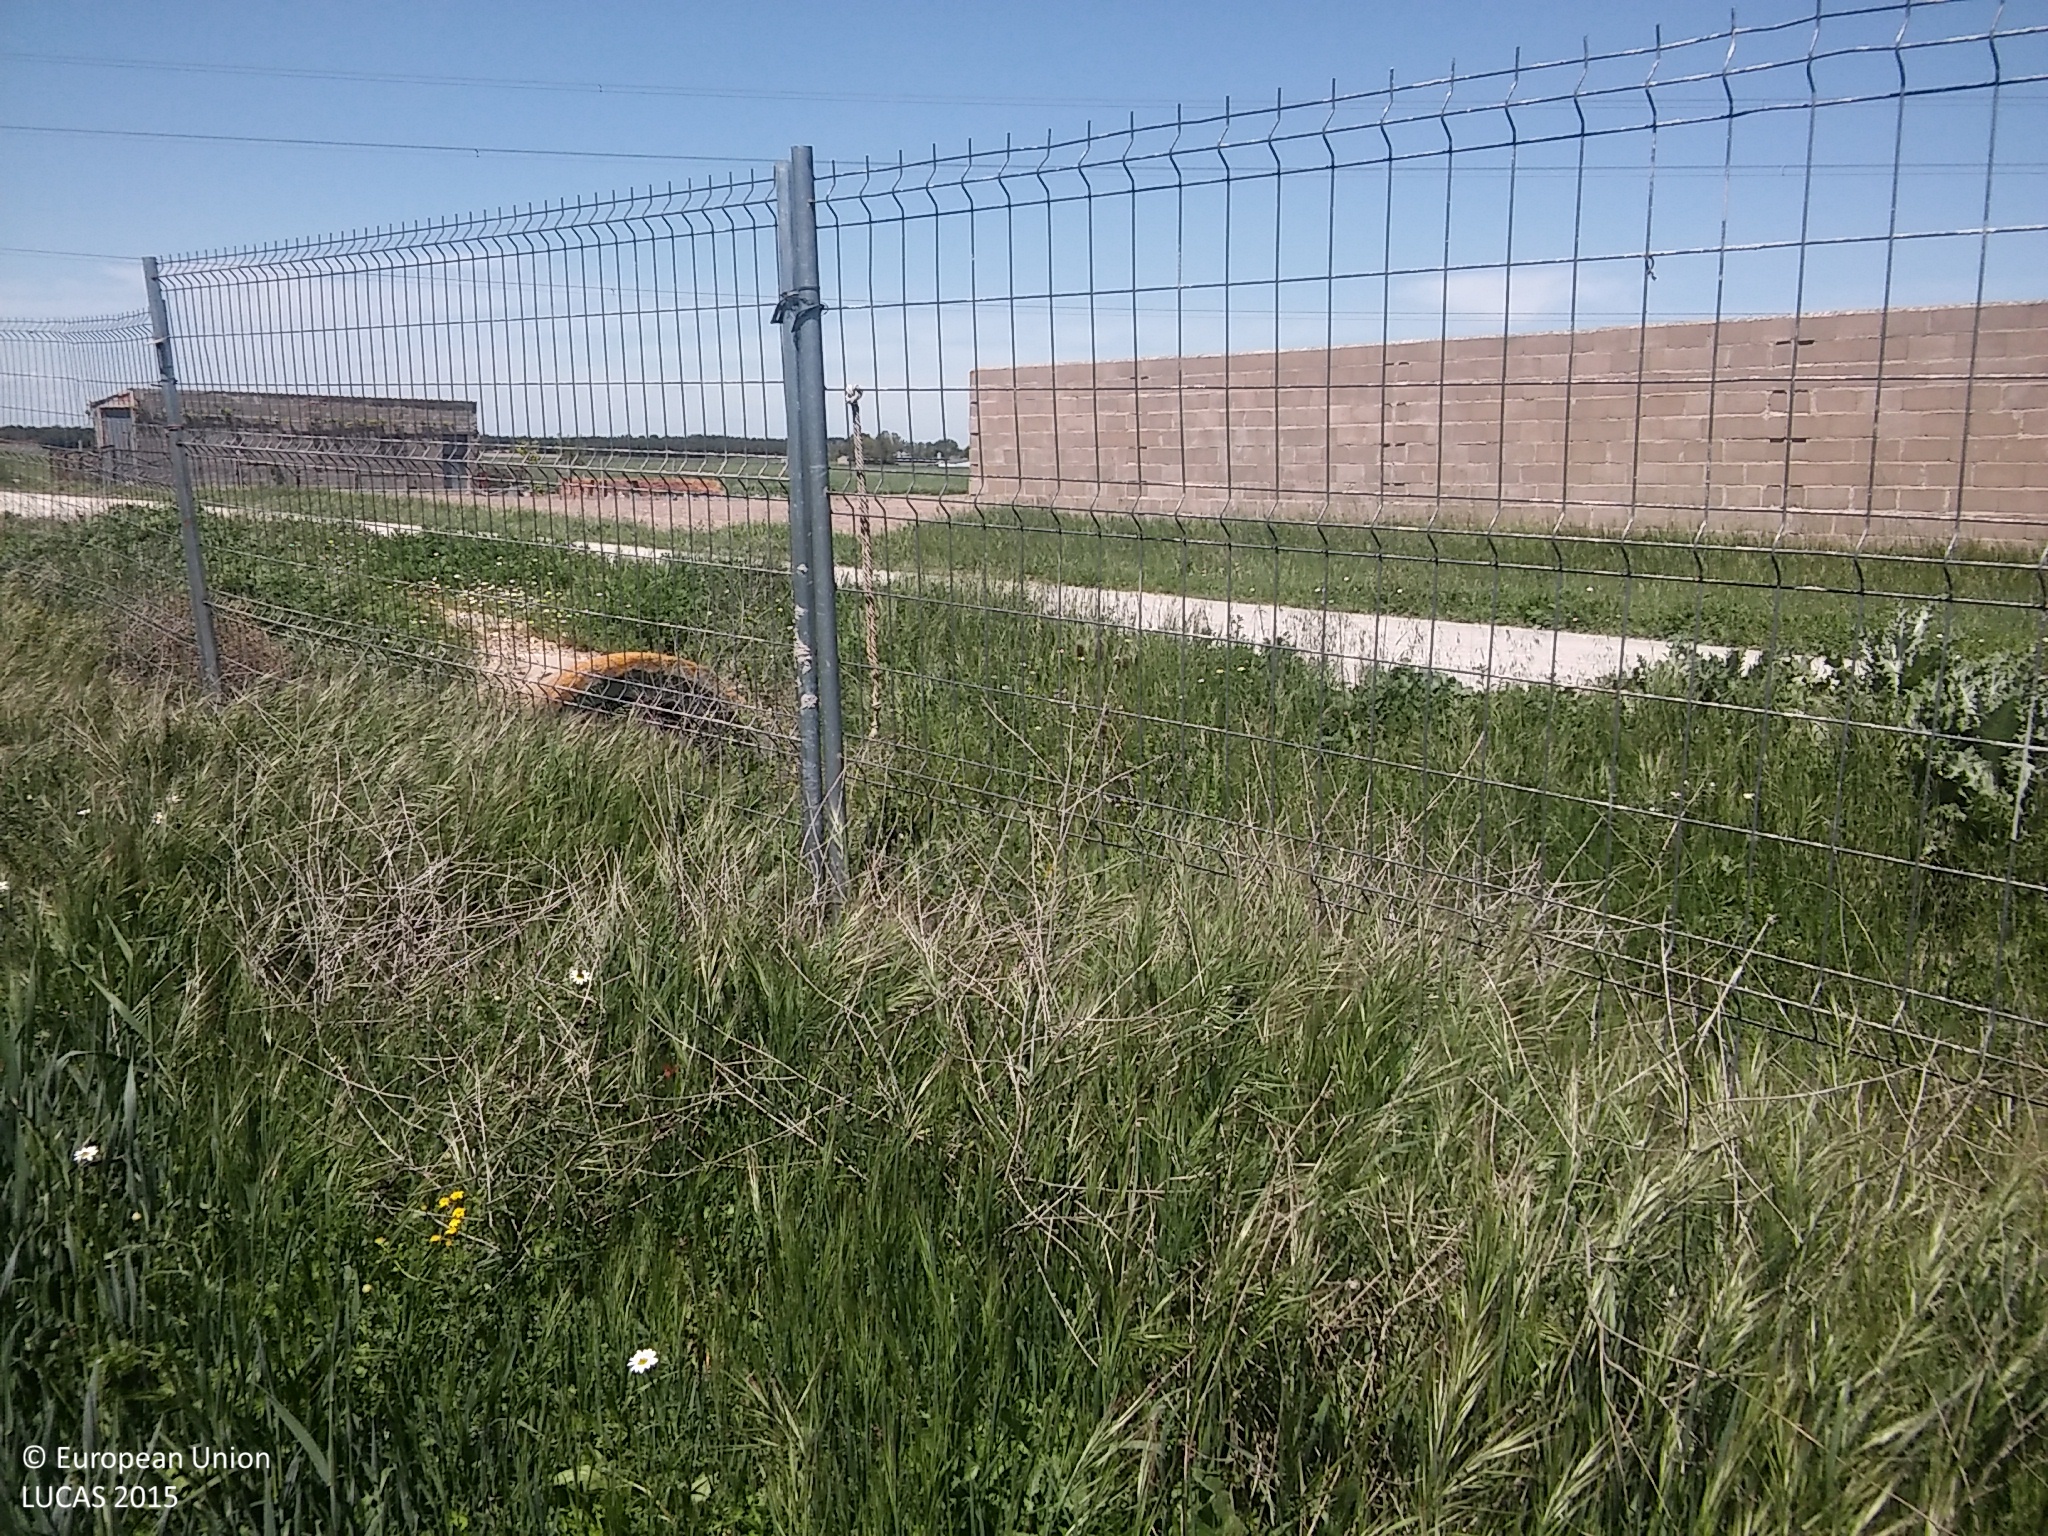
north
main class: Cropland
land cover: Common wheat
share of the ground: > 75 %
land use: Agriculture (excluding fallow land and kitchen gardens)
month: May
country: ES
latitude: 41.2646
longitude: -3.9335
